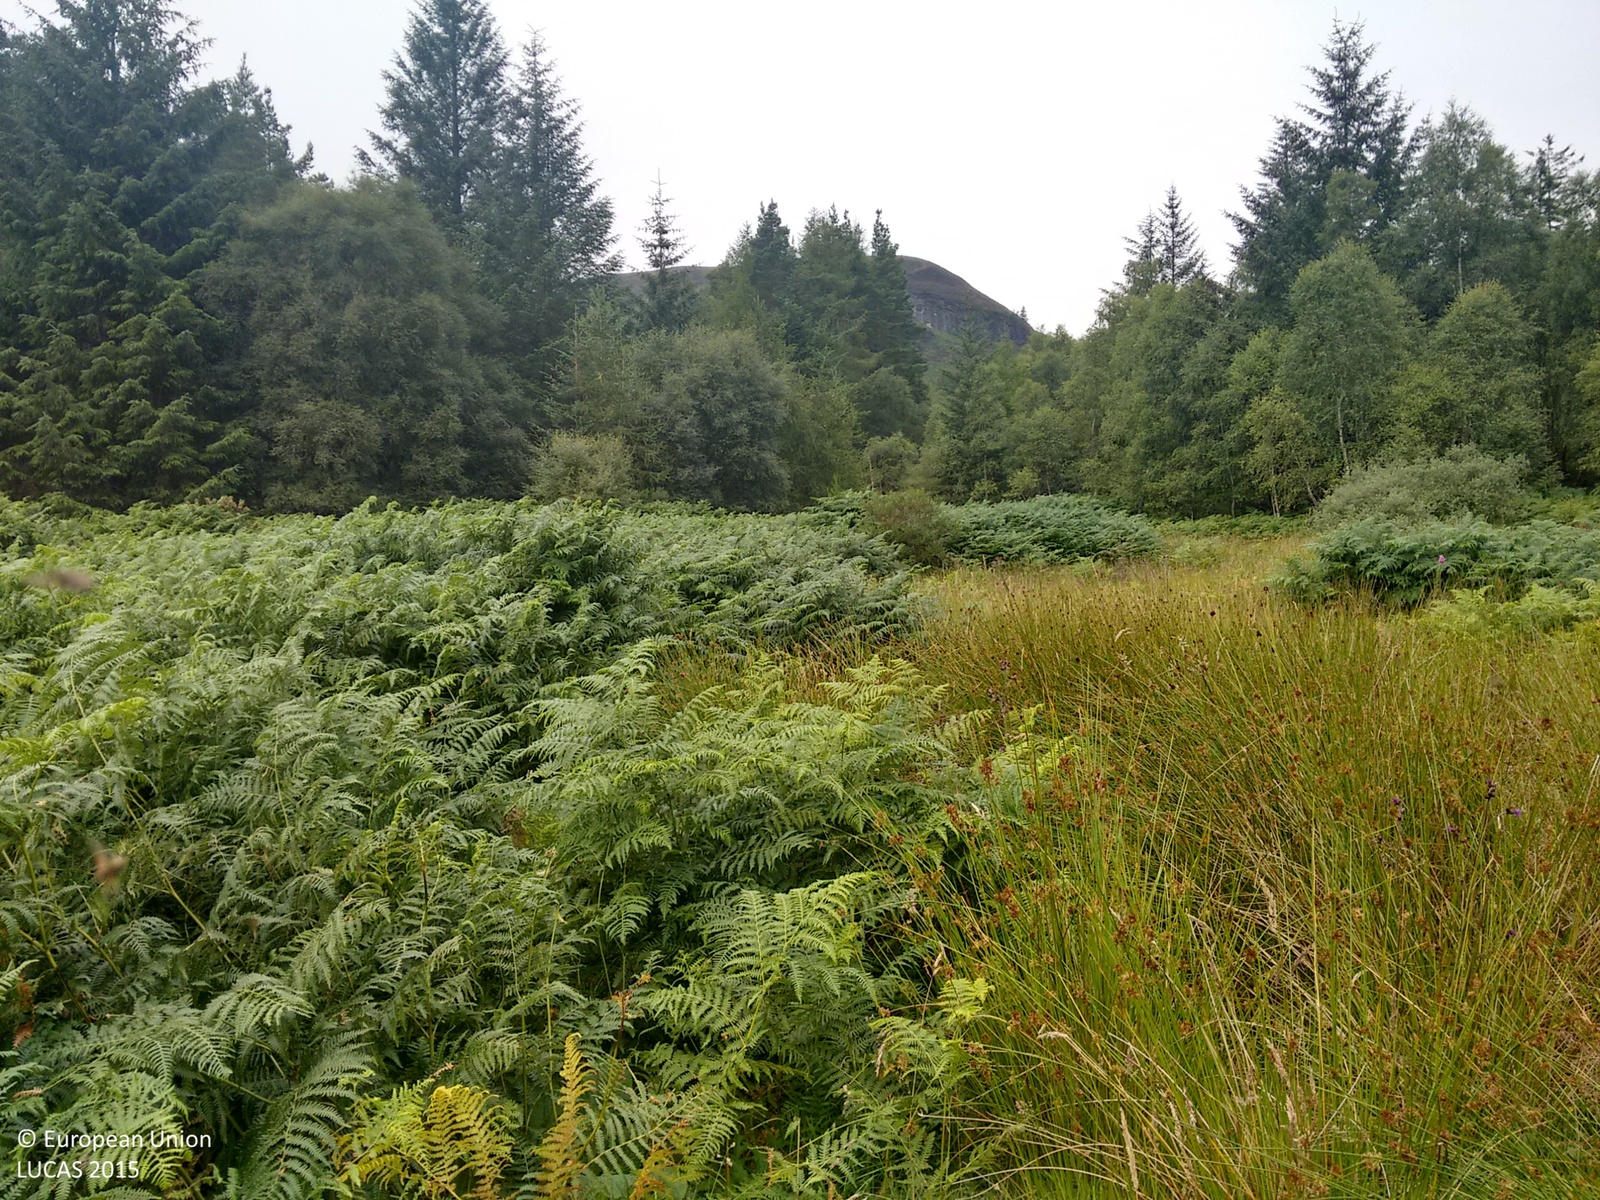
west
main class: Grassland
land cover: Grassland without tree/shrub cover
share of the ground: > 75 %
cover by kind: herbaceous plants 100 %
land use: Agriculture (excluding fallow land and kitchen gardens)
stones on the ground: < 10 %
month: August
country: GB
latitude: 57.5291
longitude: -4.5718
